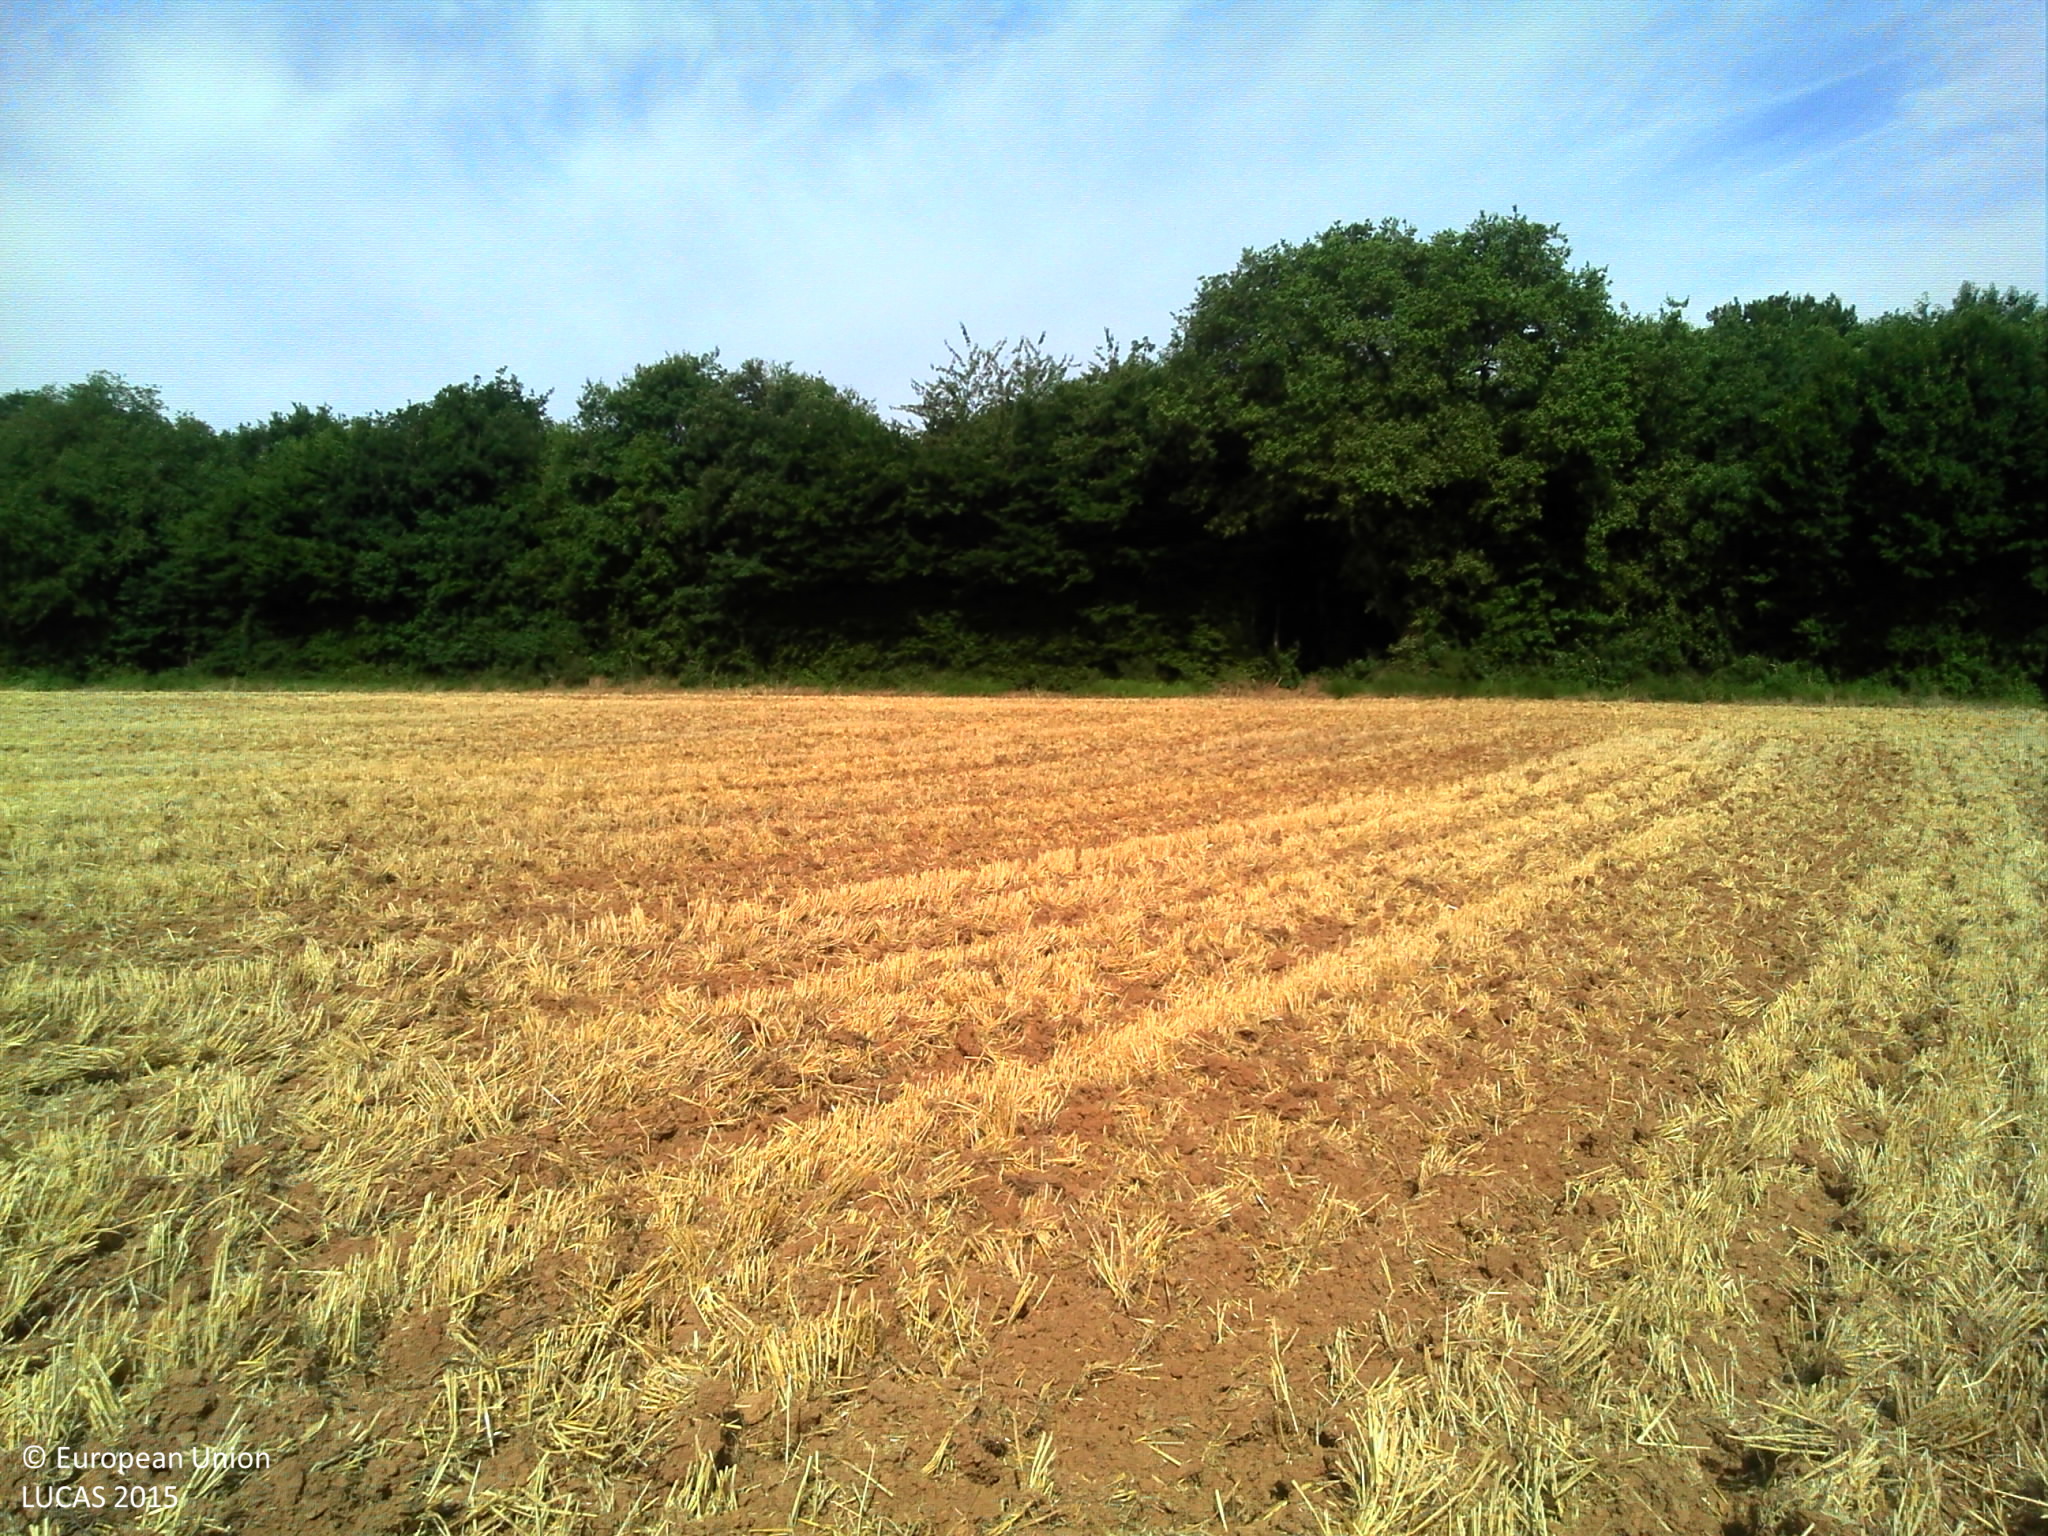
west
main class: Cropland
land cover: Barley
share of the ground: < 10 %
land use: Agriculture (excluding fallow land and kitchen gardens)
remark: Harvested field
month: June
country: FR
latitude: 46.4875
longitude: 0.2755
